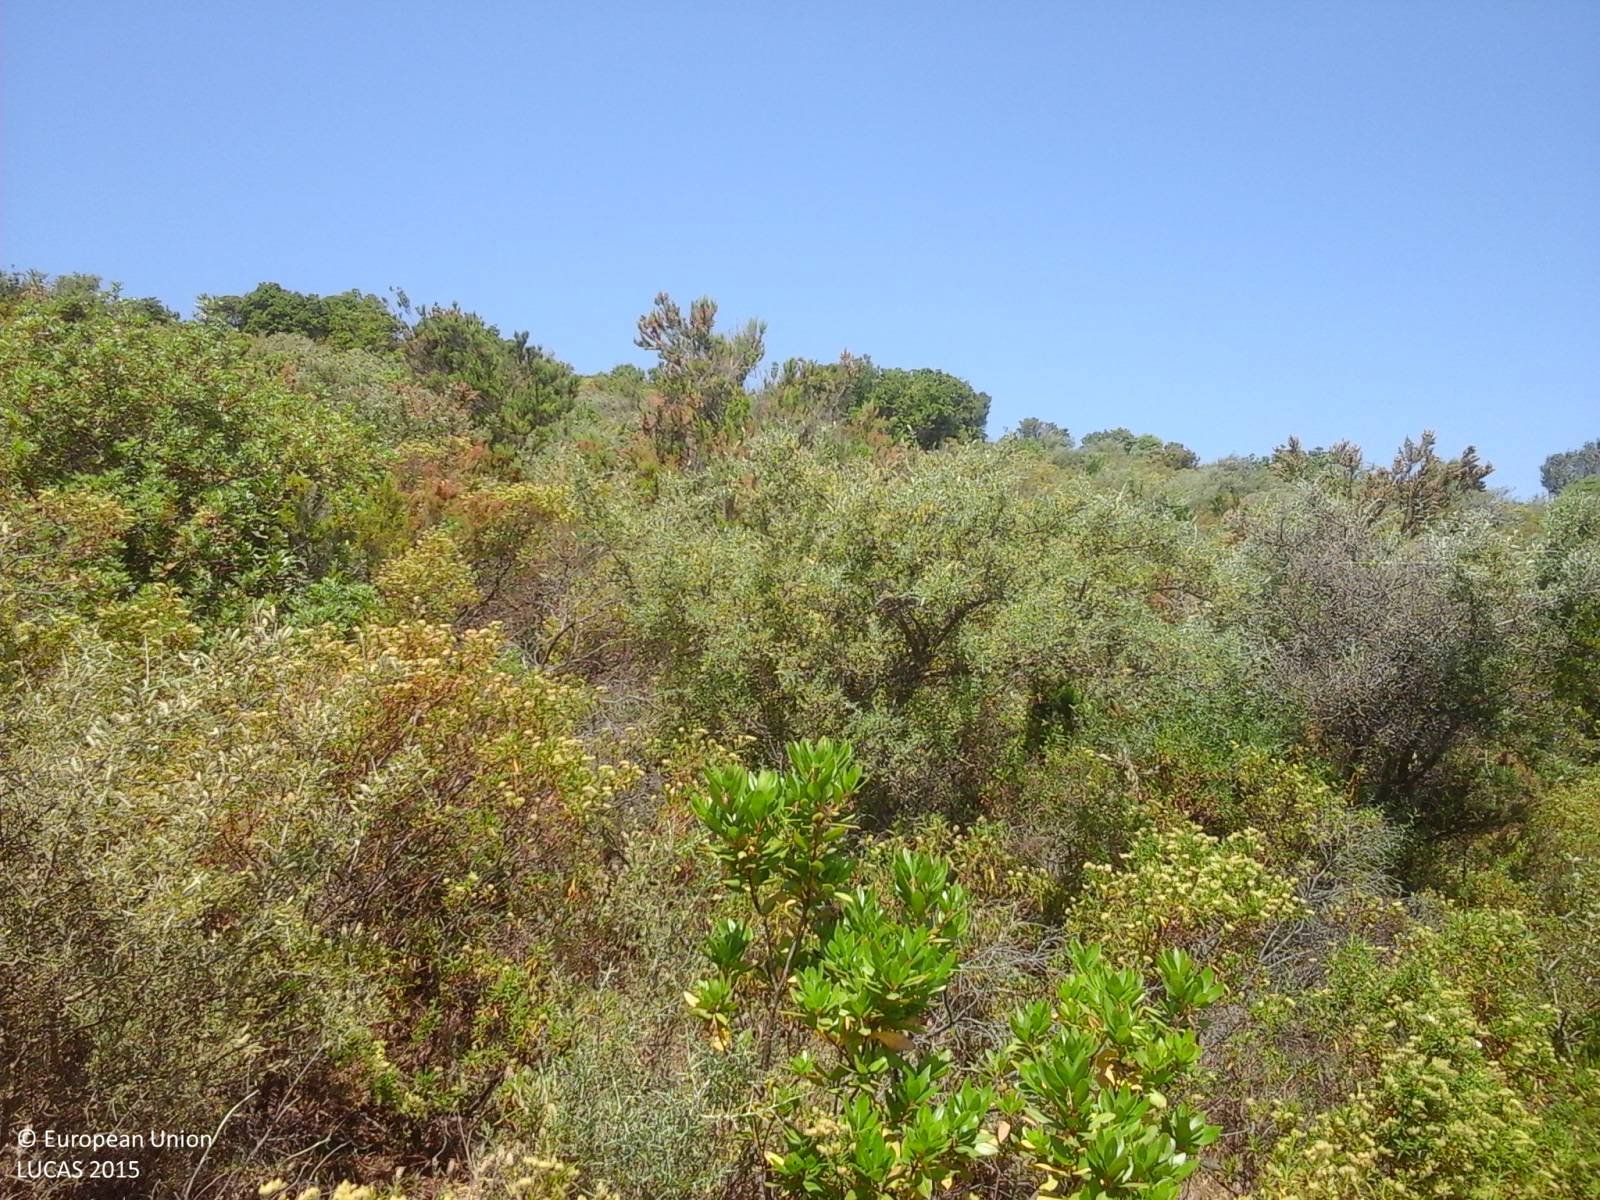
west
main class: Shrubland
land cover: Shrubland without tree cover
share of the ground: > 75 %
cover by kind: shrubs 90 %, herbaceous plants 10 %
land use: Semi-natural and natural areas not in use
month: June
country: IT
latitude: 38.9561
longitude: 8.8420
